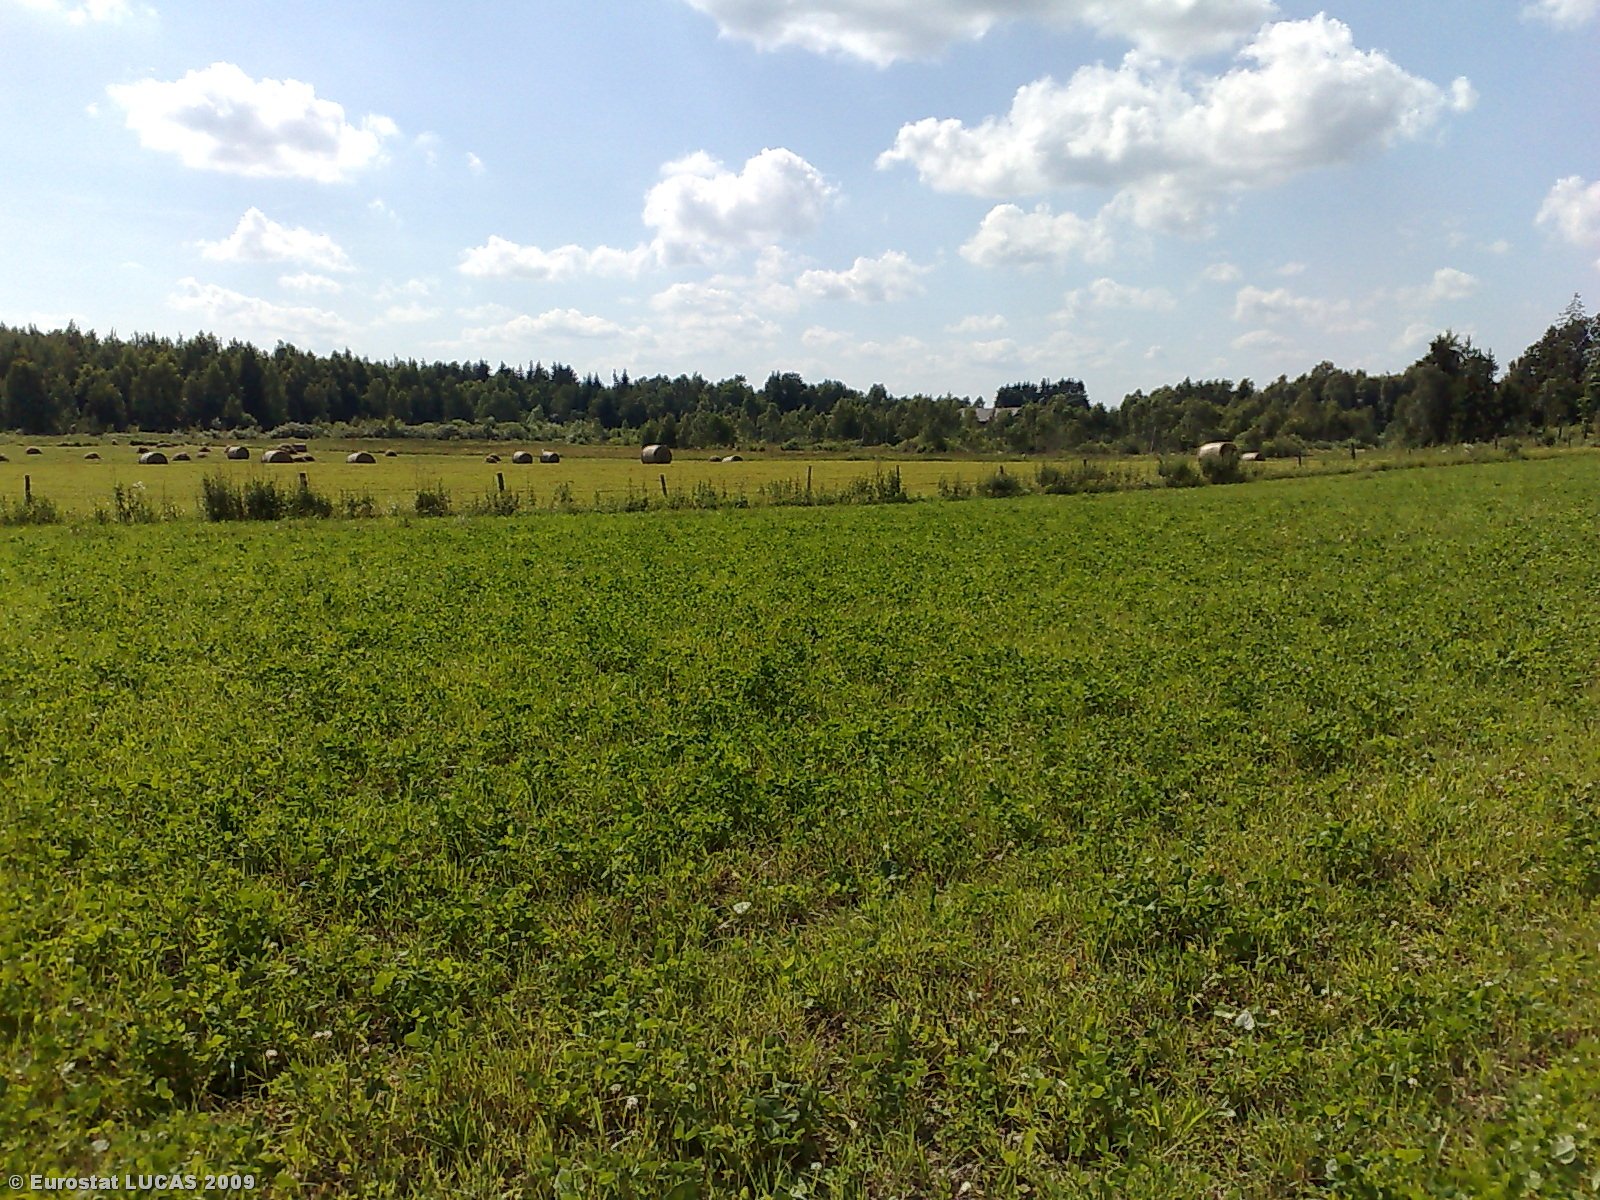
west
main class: Cropland
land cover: Clovers
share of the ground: > 75 %
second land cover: Grassland without tree/shrub cover
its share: 50 - 75 %
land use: Agriculture (excluding fallow land and kitchen gardens)
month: July
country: LT
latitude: 55.5265
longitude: 22.7864
